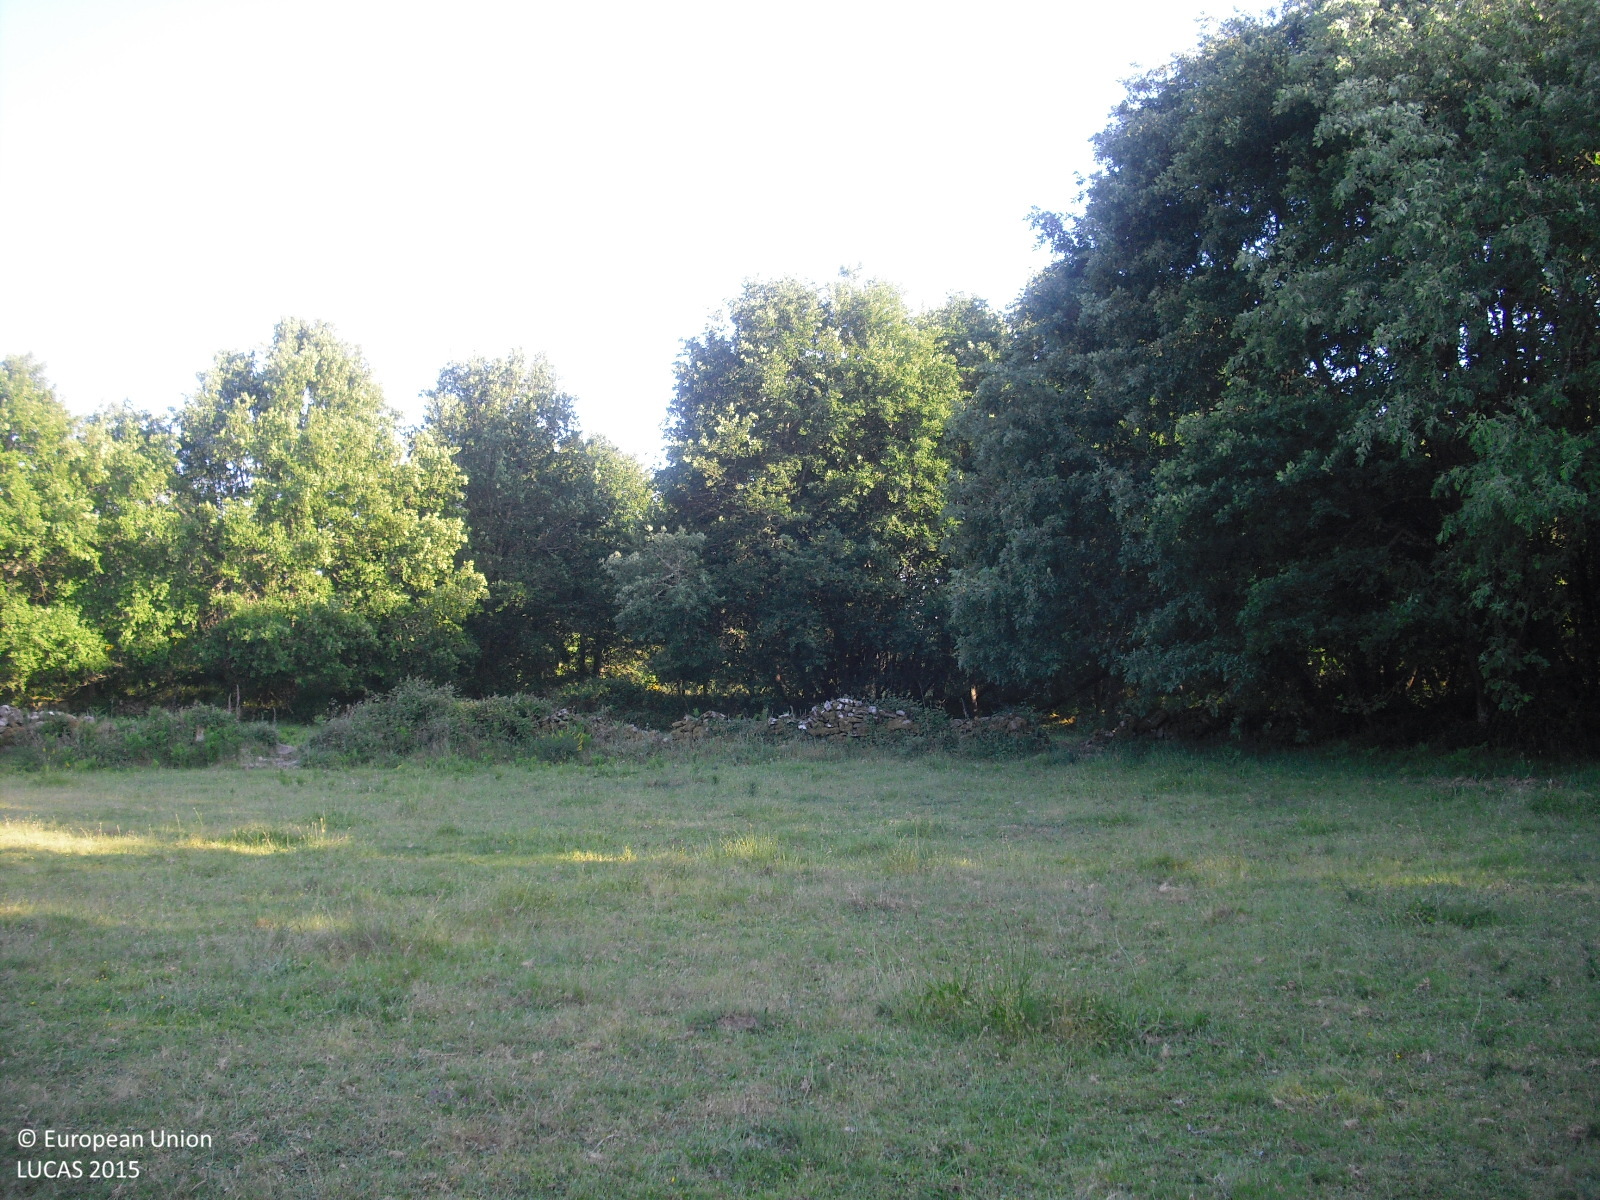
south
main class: Grassland
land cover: Grassland without tree/shrub cover
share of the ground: > 75 %
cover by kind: herbaceous plants 100 %
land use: Agriculture (excluding fallow land and kitchen gardens)
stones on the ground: < 10 %
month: May
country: ES
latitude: 42.2375
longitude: -7.7278
